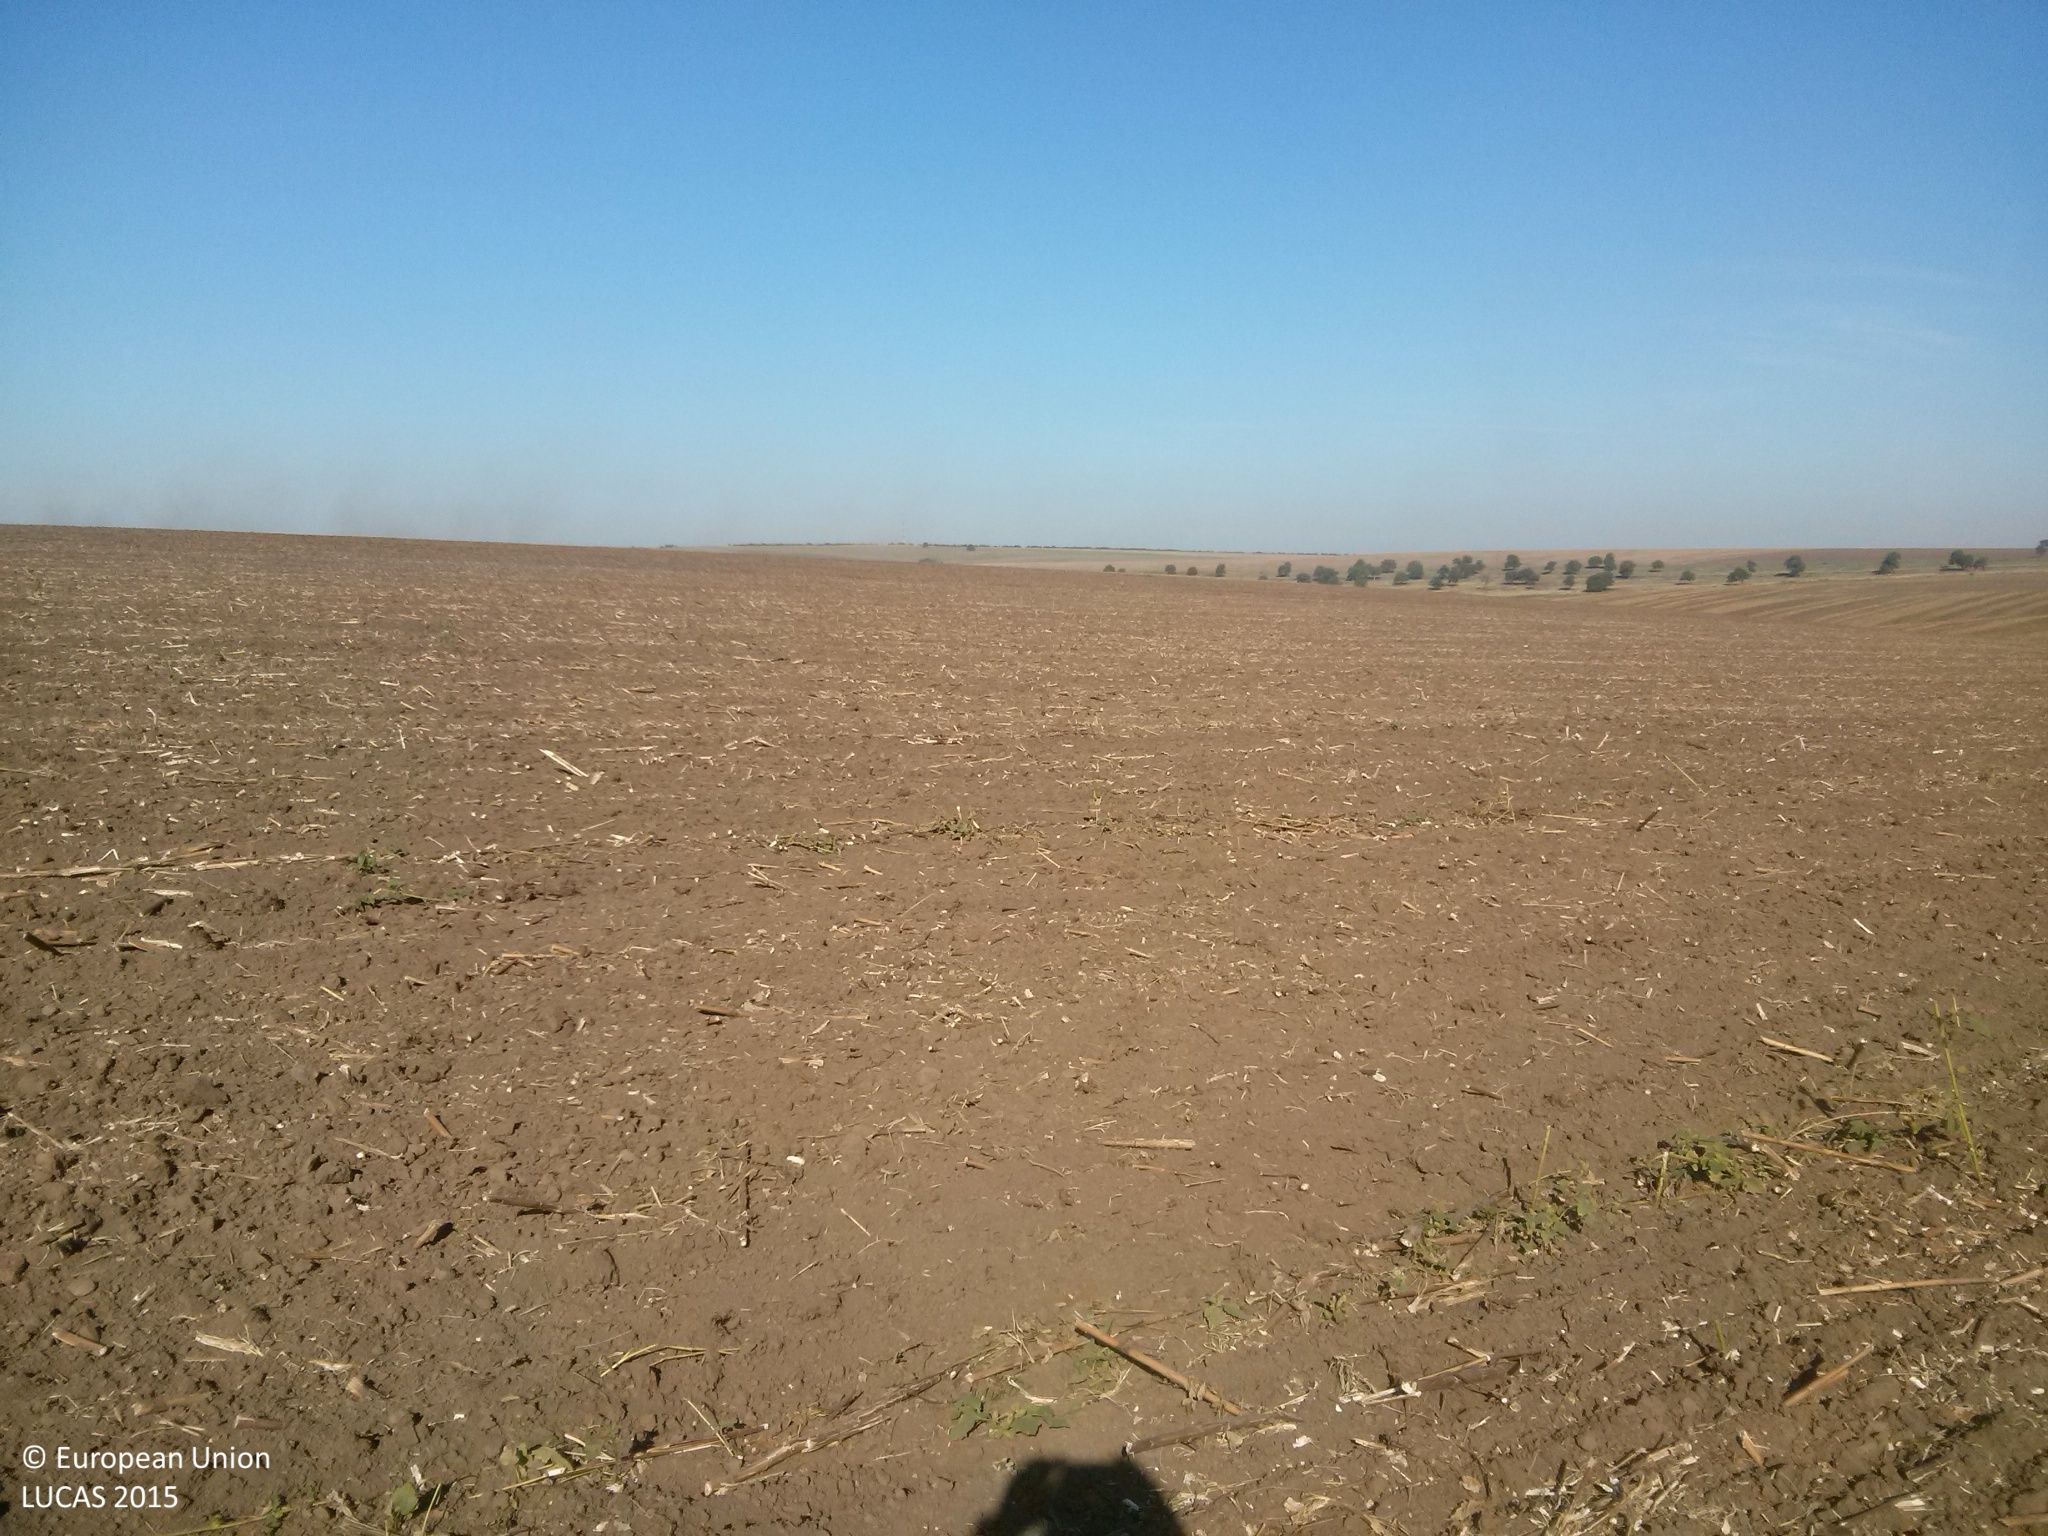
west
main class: Cropland
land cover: Sunflower
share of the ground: < 10 %
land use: Agriculture (excluding fallow land and kitchen gardens)
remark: Harvested field
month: September
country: BG
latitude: 43.7459
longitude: 26.4355
